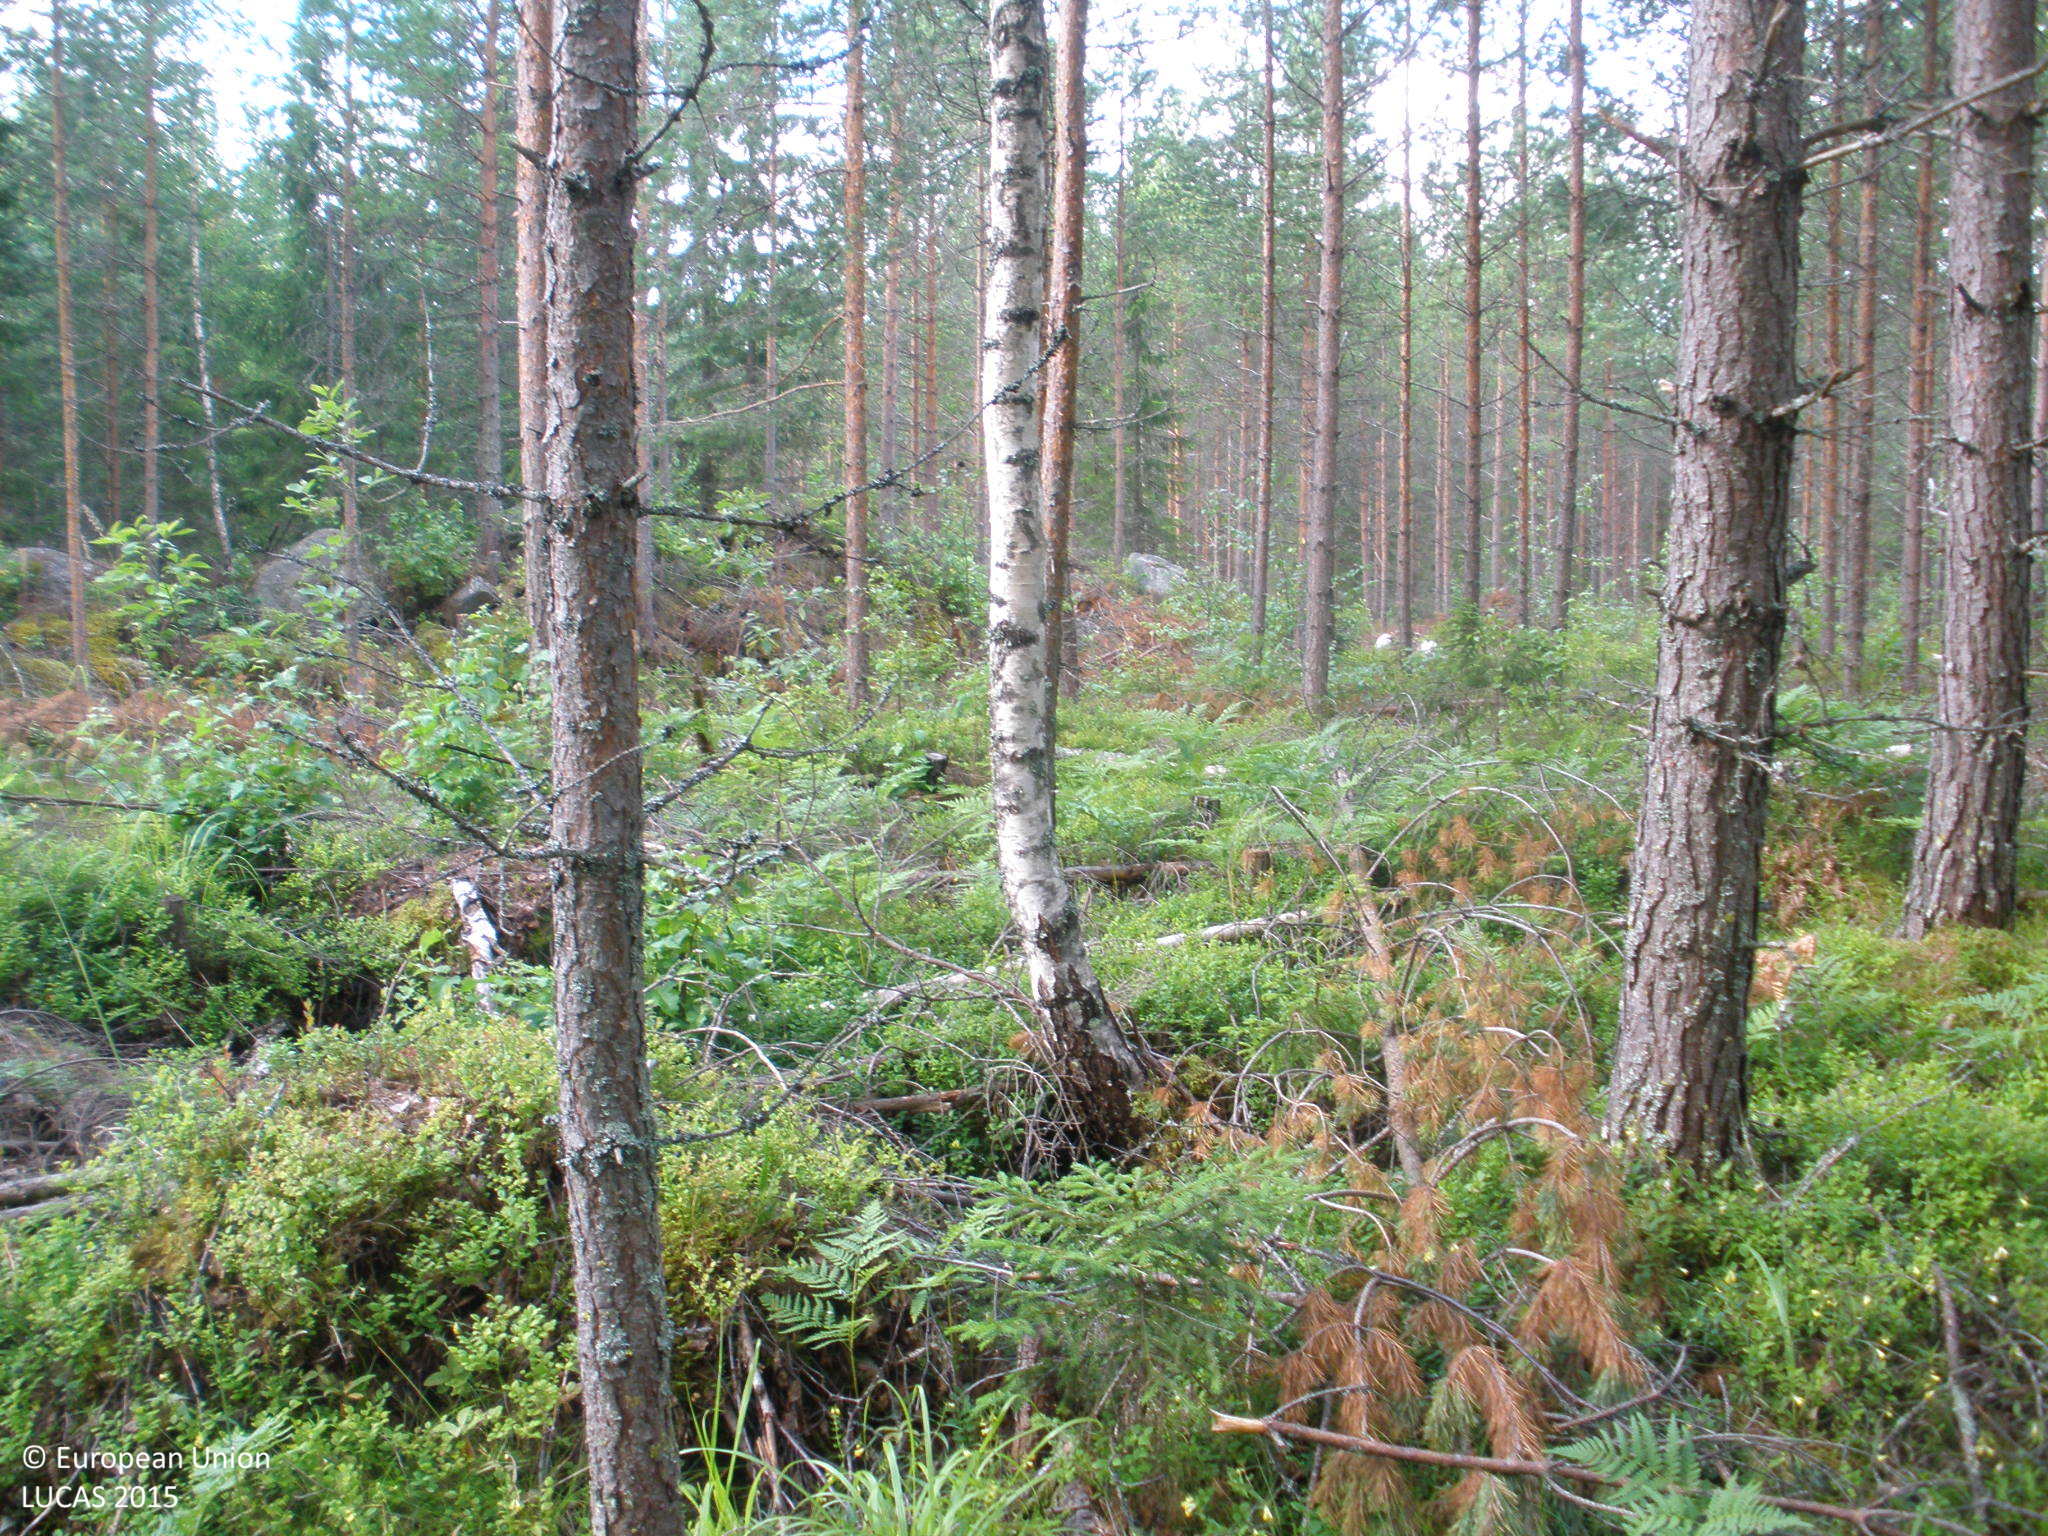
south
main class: Woodland
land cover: Pine dominated coniferous woodland
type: boreal forest
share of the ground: > 75 %
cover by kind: coniferous forest trees 70 %, herbaceous plants 15 %, lichens and mosses 10 %, broadleaved forest trees 5 %
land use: Forestry
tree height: > 5 m
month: July
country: FI
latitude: 60.9749
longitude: 25.1381
